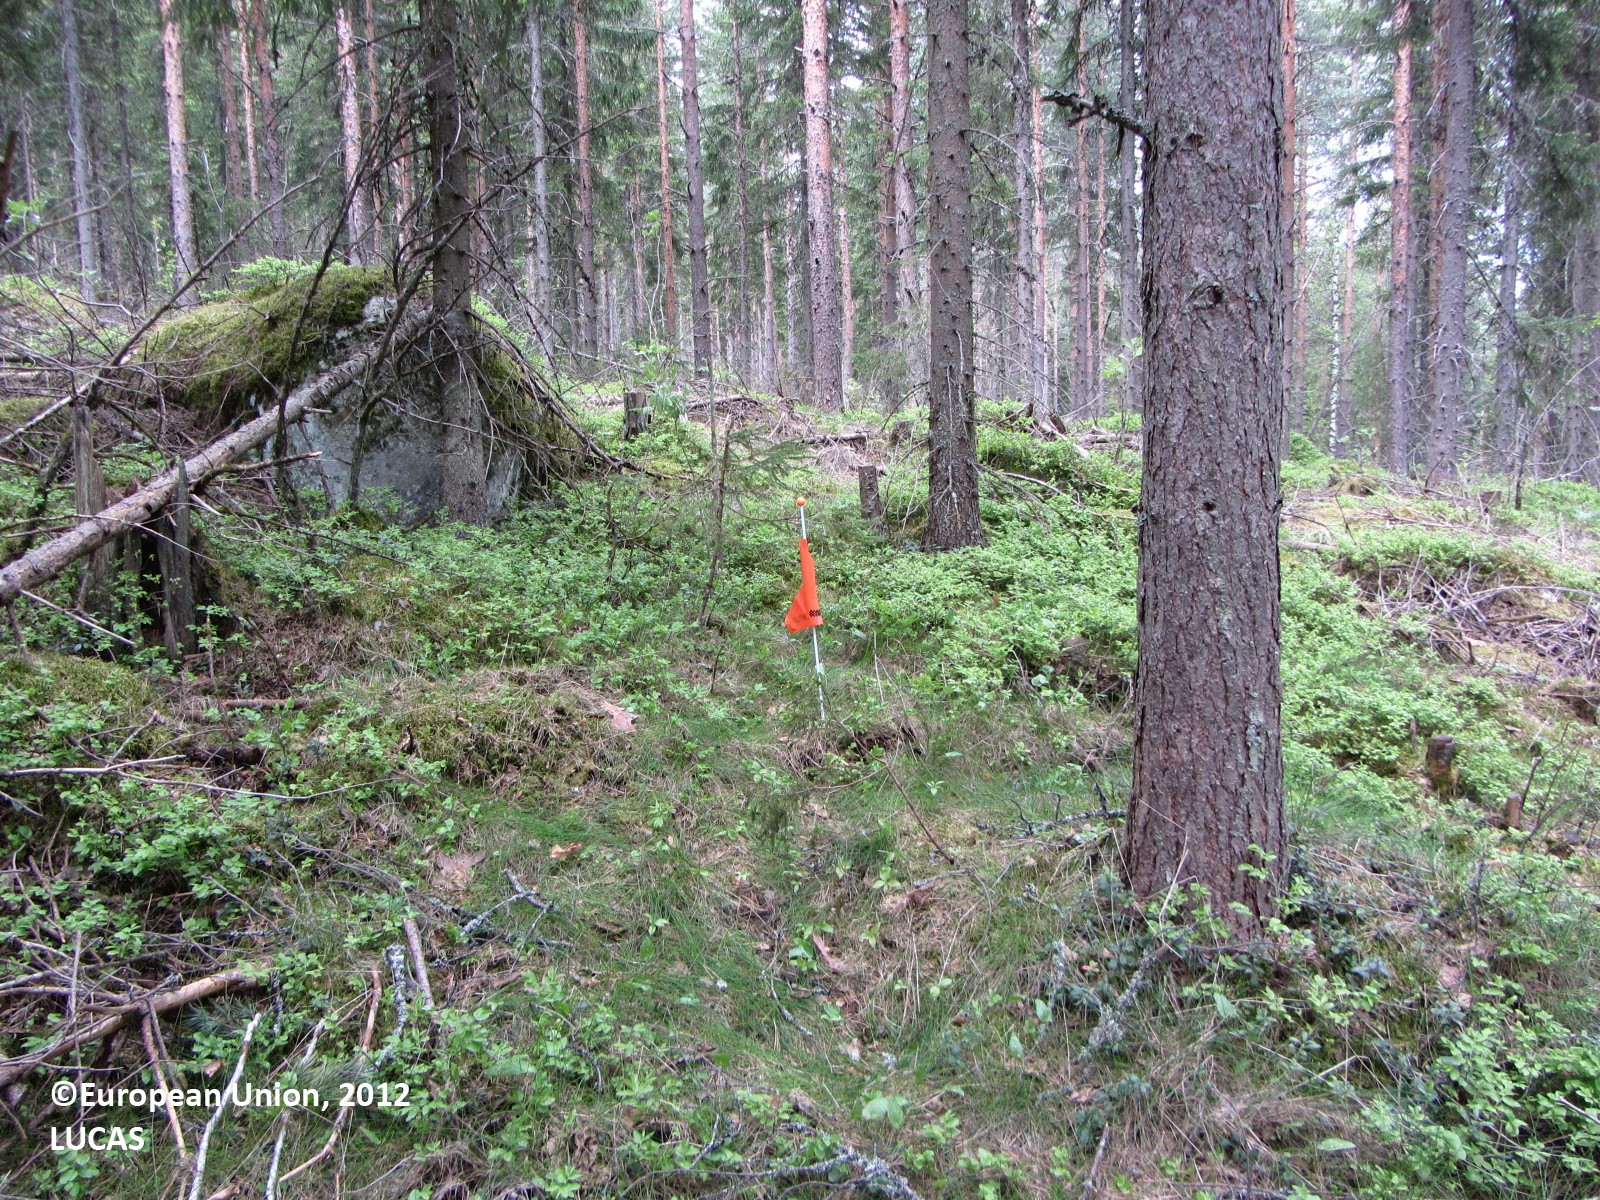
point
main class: Woodland
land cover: Pine dominated coniferous woodland
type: boreal forest
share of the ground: > 75 %
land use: Forestry
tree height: > 5 m
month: May
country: FI
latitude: 62.4636
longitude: 25.5270
